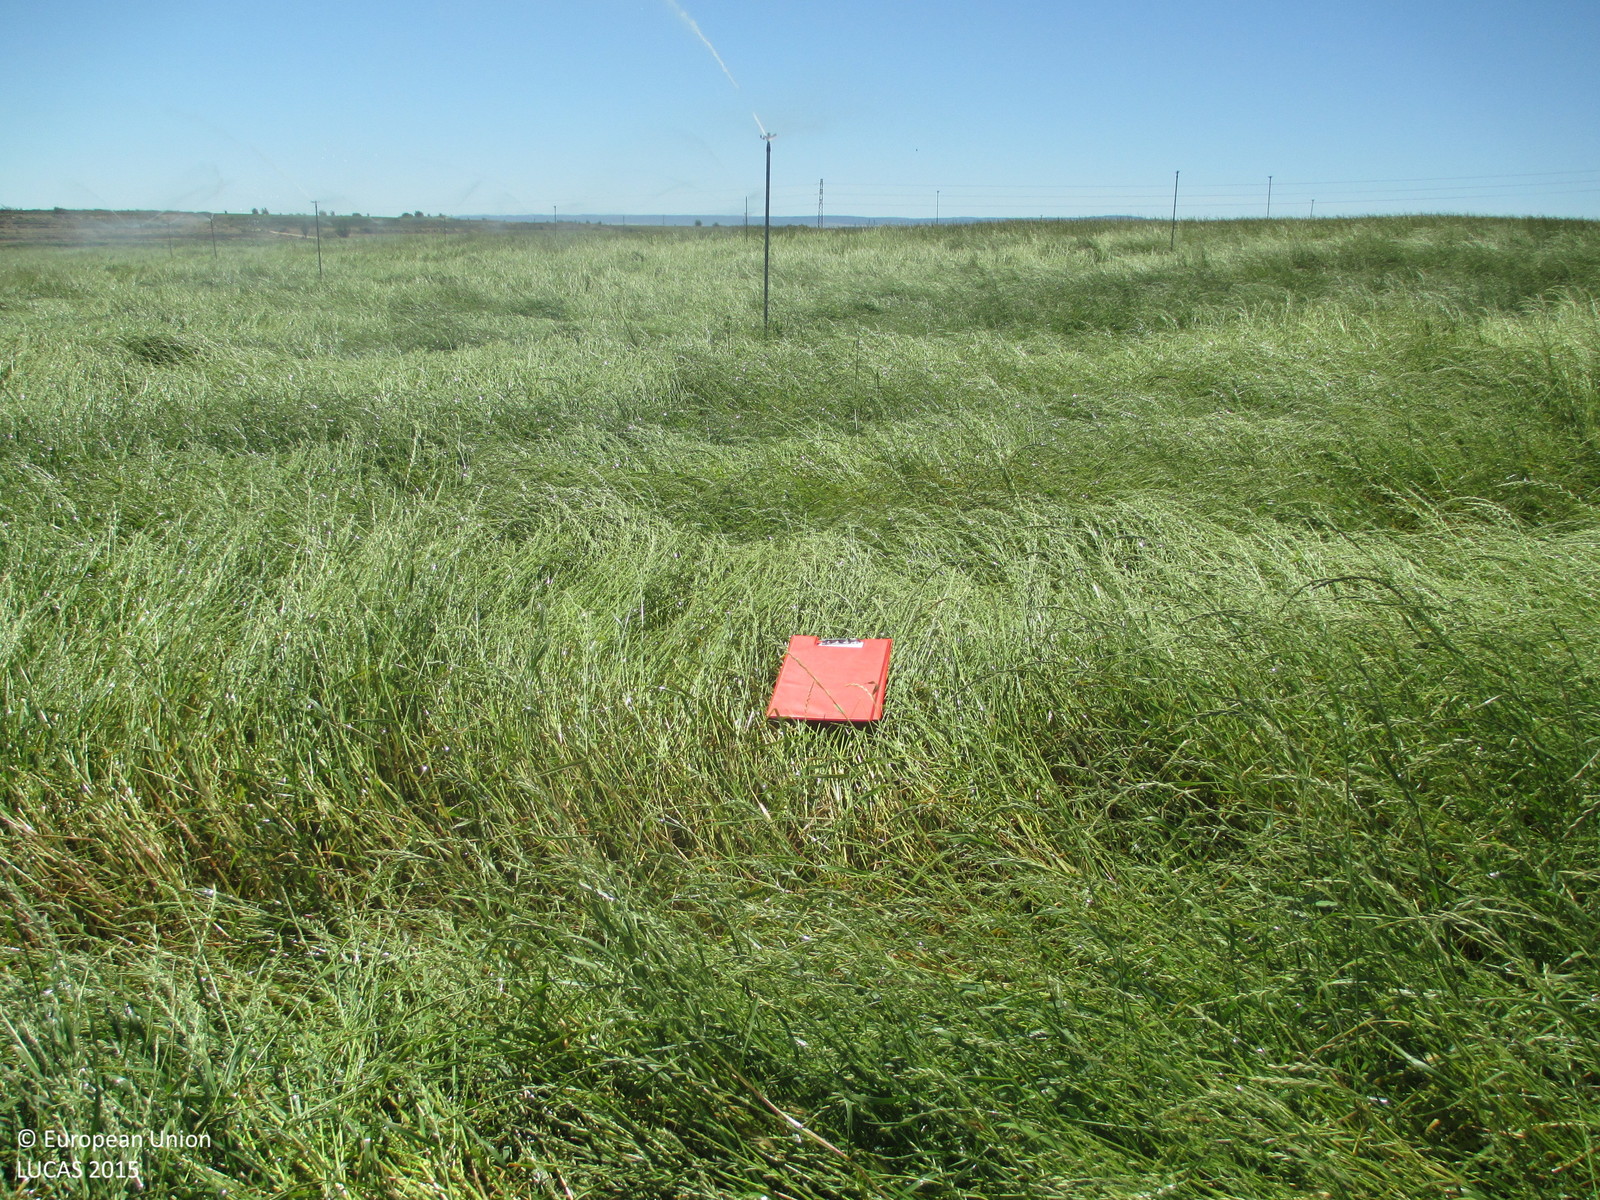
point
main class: Cropland
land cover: Temporary grasslands
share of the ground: > 75 %
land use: Agriculture (excluding fallow land and kitchen gardens)
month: May
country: ES
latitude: 41.8780
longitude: -0.2496
